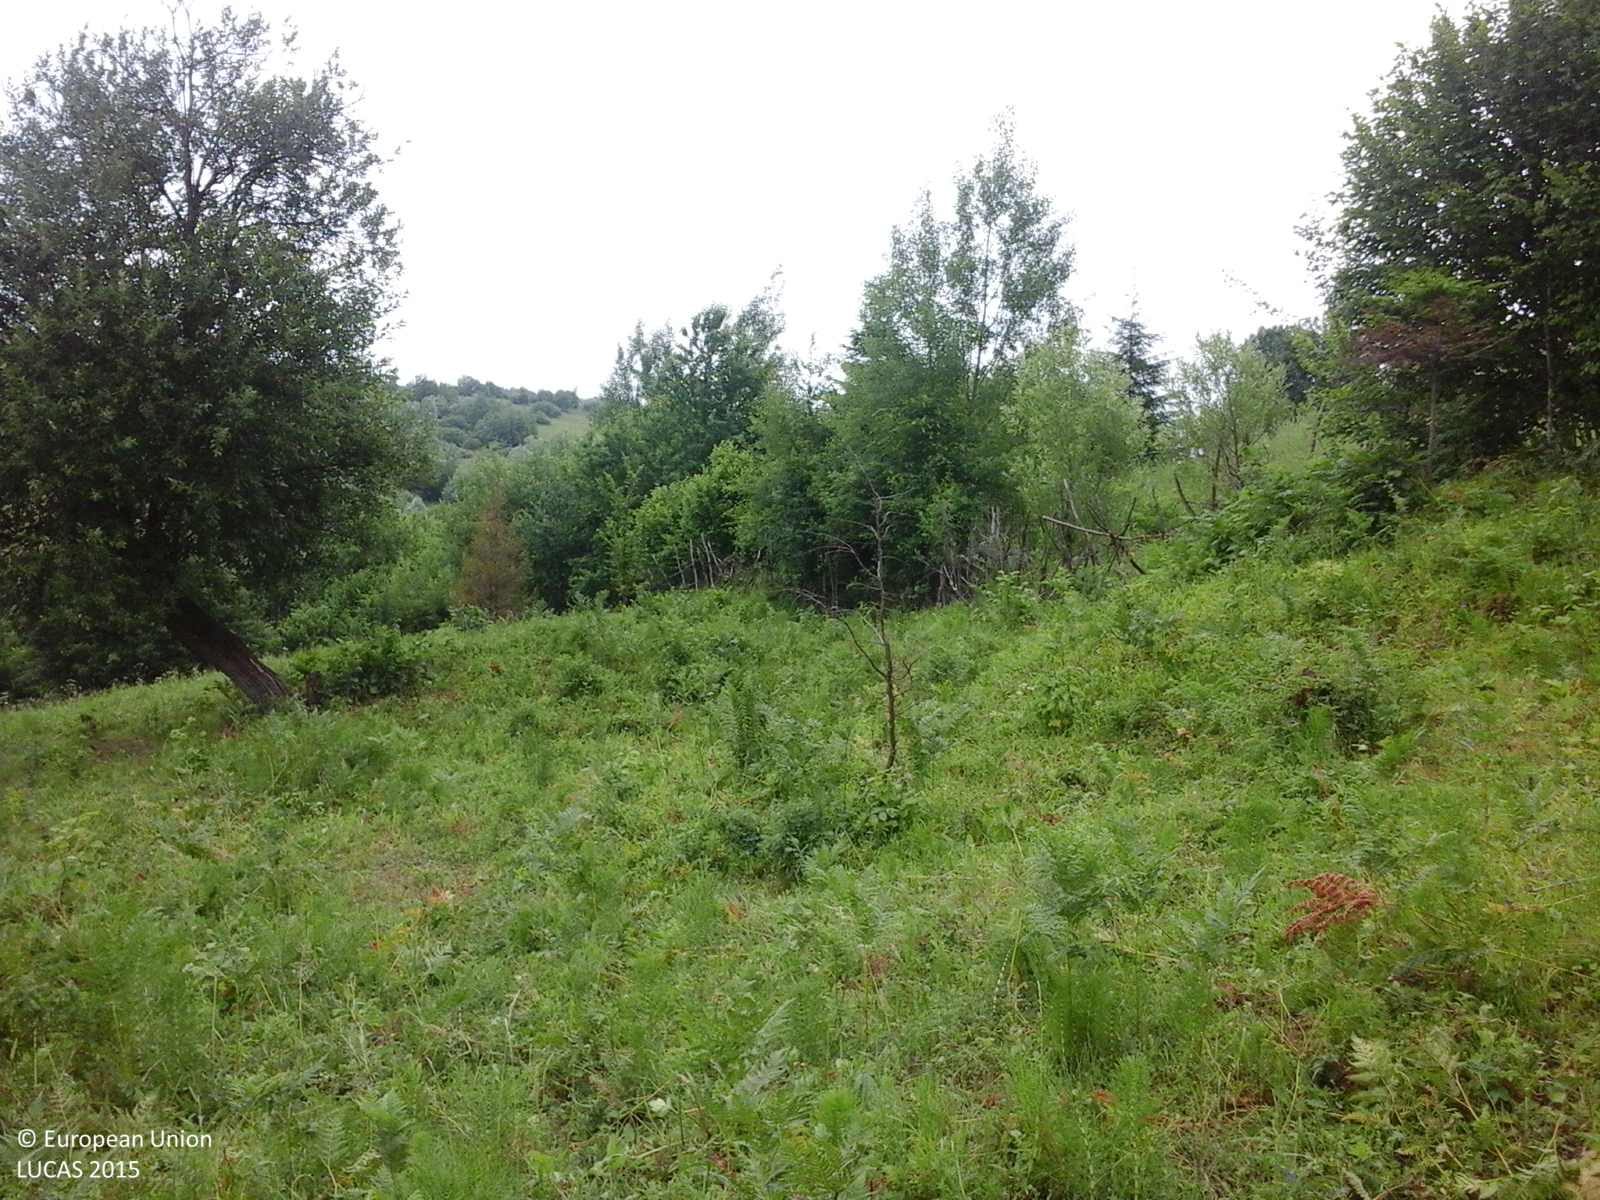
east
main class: Grassland
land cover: Spontaneously vegetated surfaces
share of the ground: > 75 %
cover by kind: herbaceous plants 100 %
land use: Agriculture (excluding fallow land and kitchen gardens)
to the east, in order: Spontaneously vegetated surfaces; Grassland with sparse tree/shrub cover; Fences; Broadleaved woodland; Grassland with sparse tree/shrub cover; Fences; Grassland with sparse tree/shrub cover; Grassland without tree/shrub cover; Grassland with sparse tree/shrub cover; Broadleaved woodland; Spontaneously vegetated surfaces; Broadleaved woodland; Inland fresh running water; Broadleaved woodland; Grassland without tree/shrub cover
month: June
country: RO
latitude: 47.3389
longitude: 26.2406
